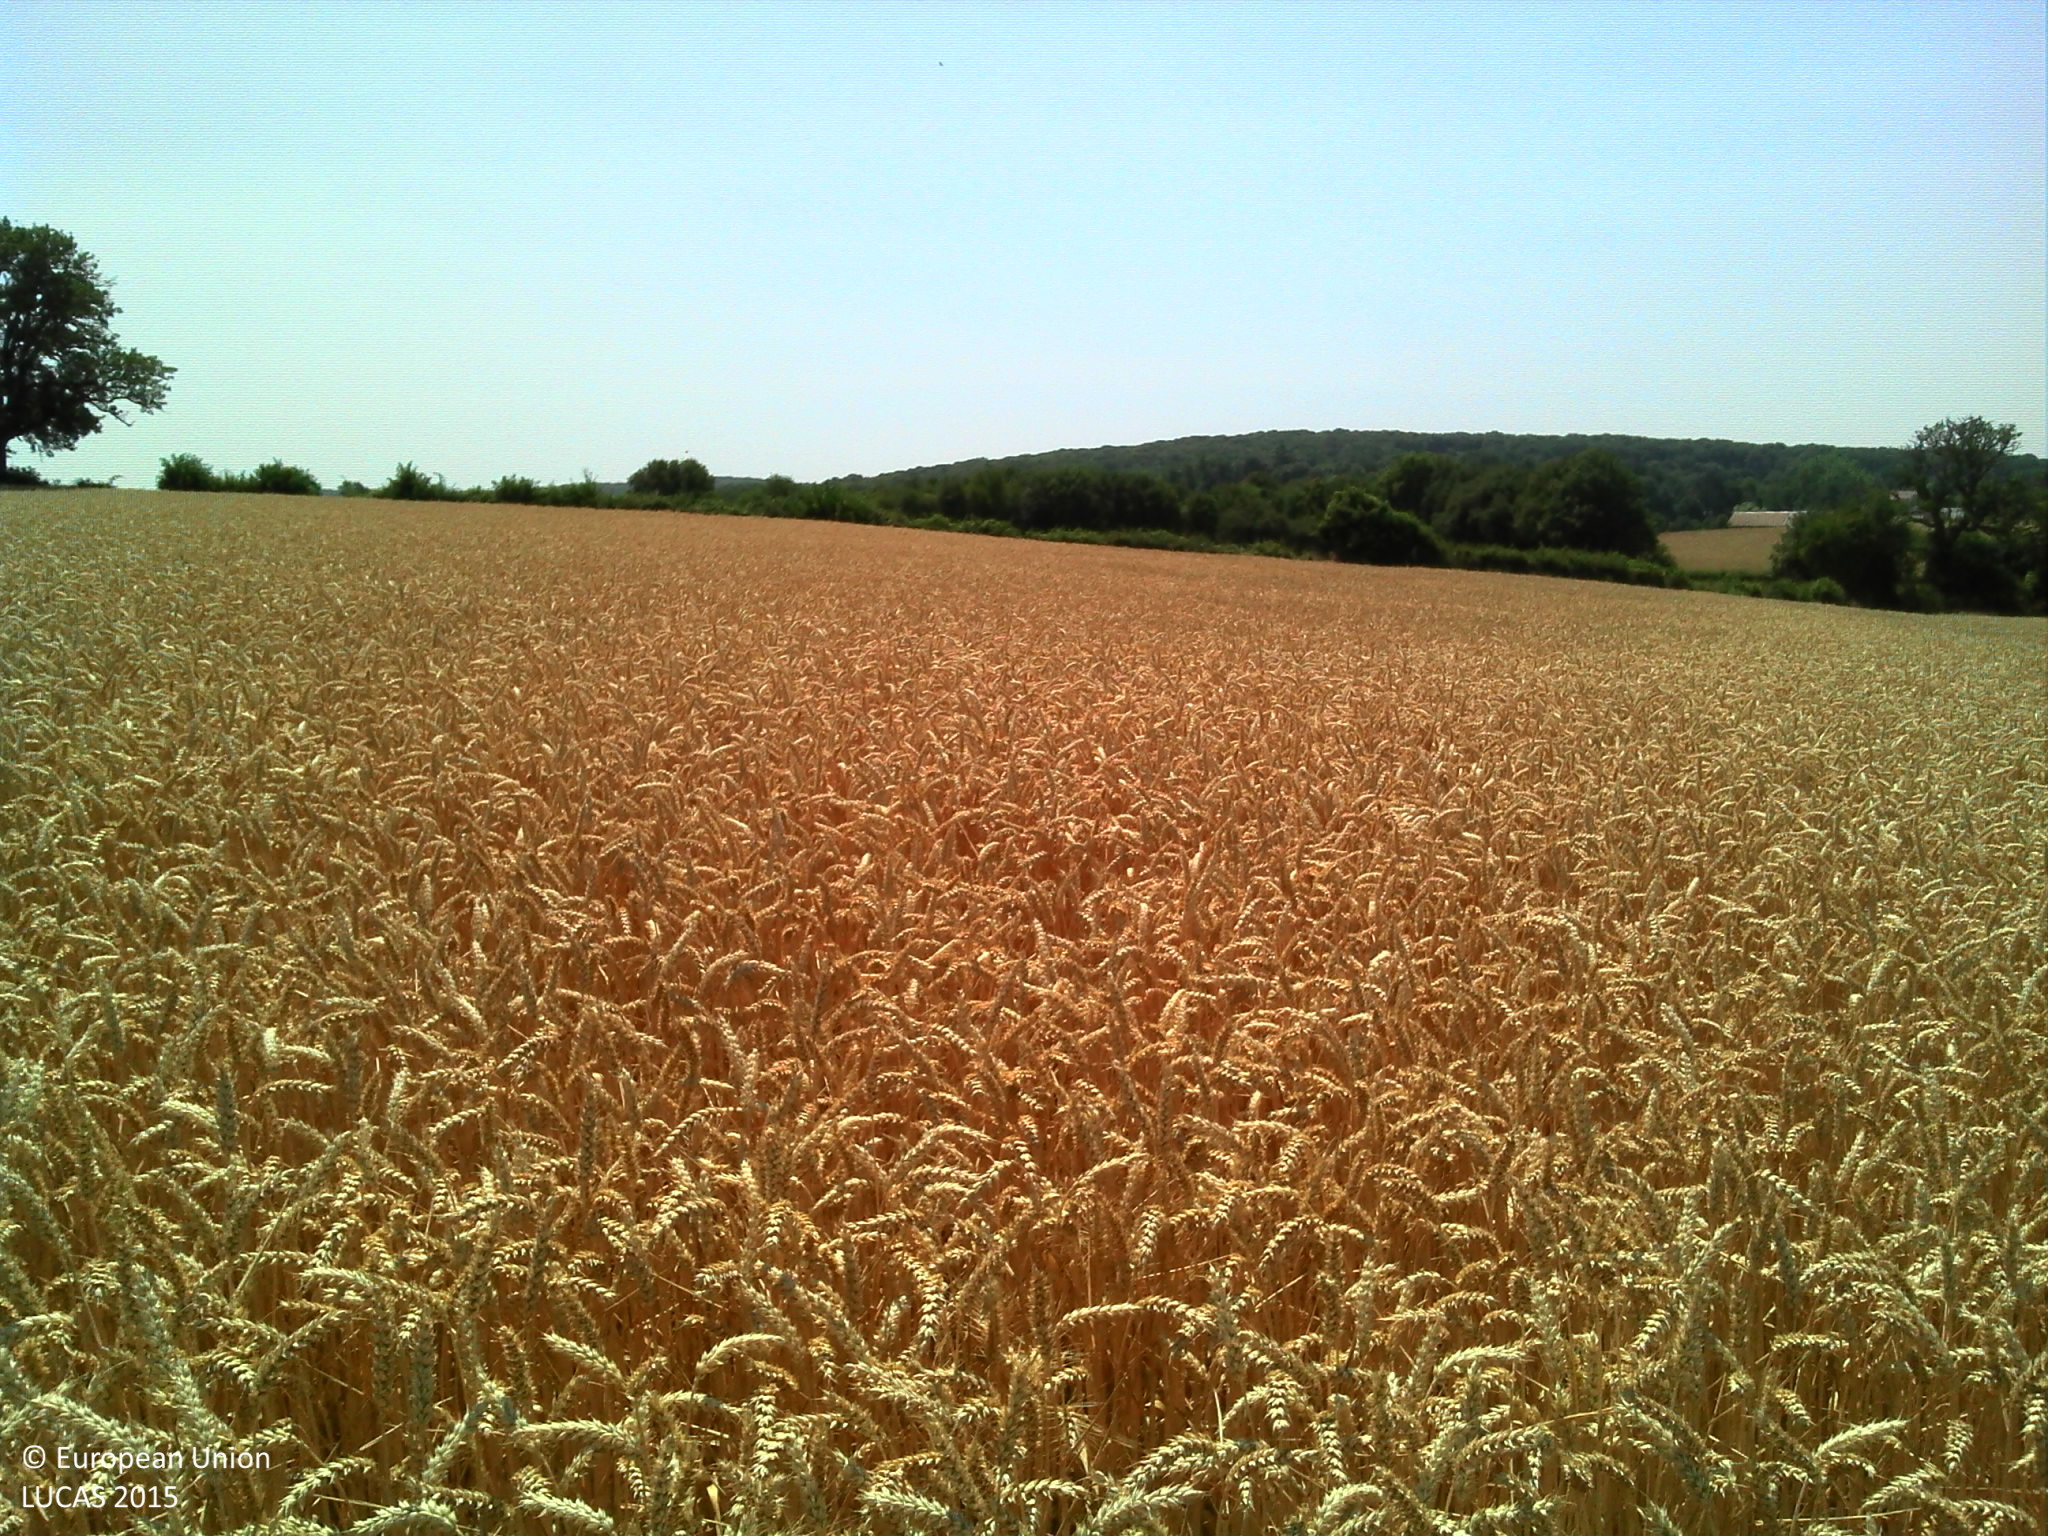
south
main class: Cropland
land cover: Common wheat
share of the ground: > 75 %
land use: Agriculture (excluding fallow land and kitchen gardens)
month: July
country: FR
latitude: 47.0259
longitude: 3.5900
